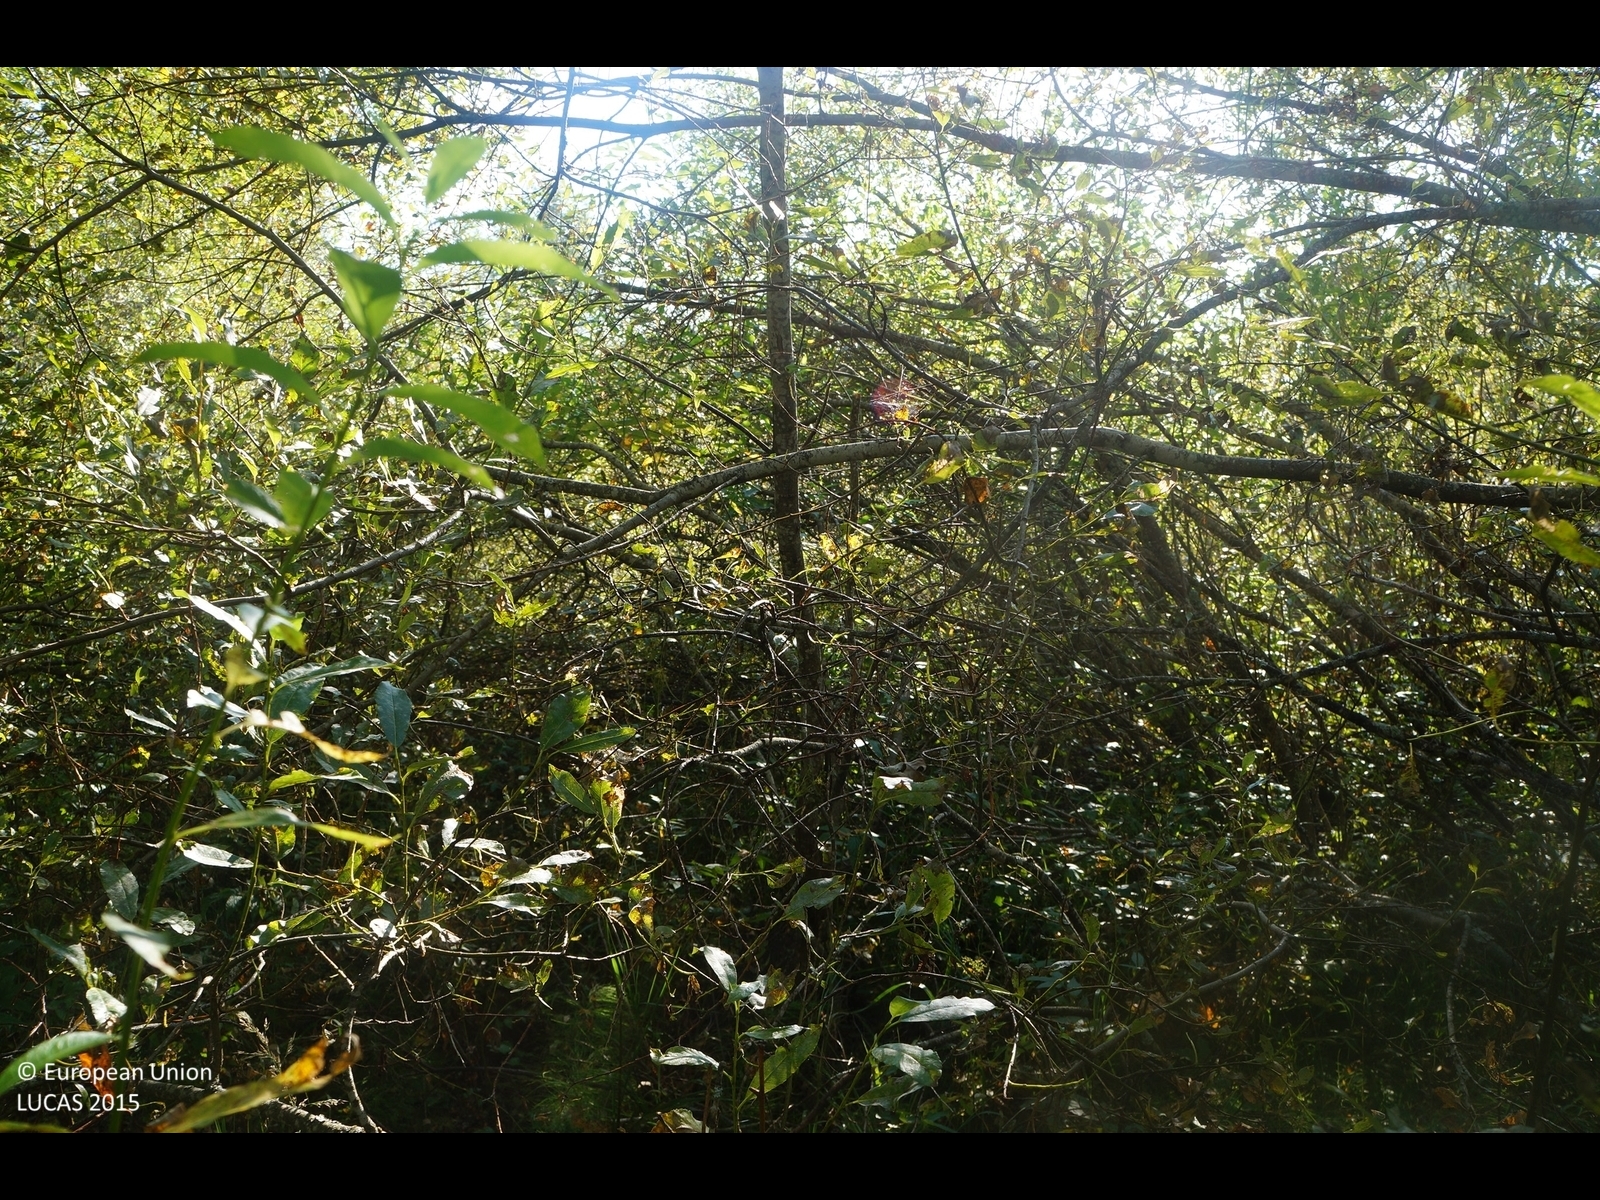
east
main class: Woodland
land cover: Broadleaved woodland
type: non-riverine alder, birch or aspen forest
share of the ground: 50 - 75 %
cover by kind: broadleaved forest trees 60 %, shrubs 30 %, herbaceous plants 10 %
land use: Semi-natural and natural areas not in use
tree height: > 5 m
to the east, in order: Broadleaved woodland; Shrubland with sparse tree cover; Spontaneously vegetated surfaces; Broadleaved woodland; Abandoned hedges; Ditches and canals; Spontaneously vegetated surfaces; Ditches and canals; Shruby margins; Other bare soil; Shrubland with sparse tree cover; Ditches and canals; Shruby margins; Other bare soil; Shrubland with sparse tree cover; Ditches and canals; Shrubland with sparse tree cover; Spontaneously vegetated surfaces; Ditches and canals; Shruby margins; Other bare soil; Shruby margins; Ditches and canals; Shruby margins; Other bare soil; Grass margins; Spontaneously vegetated surfaces; Shrubland without tree cover; Grassland with sparse tree/shrub cover; Ditches and canals; Shruby margins; Grassland without tree/shrub cover; Shrubland without tree cover; Ditches and canals; Lines of trees; Other bare soil; Shrubland with sparse tree cover; Grassland without tree/shrub cover
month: August
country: FI
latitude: 64.0901
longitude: 25.3313
